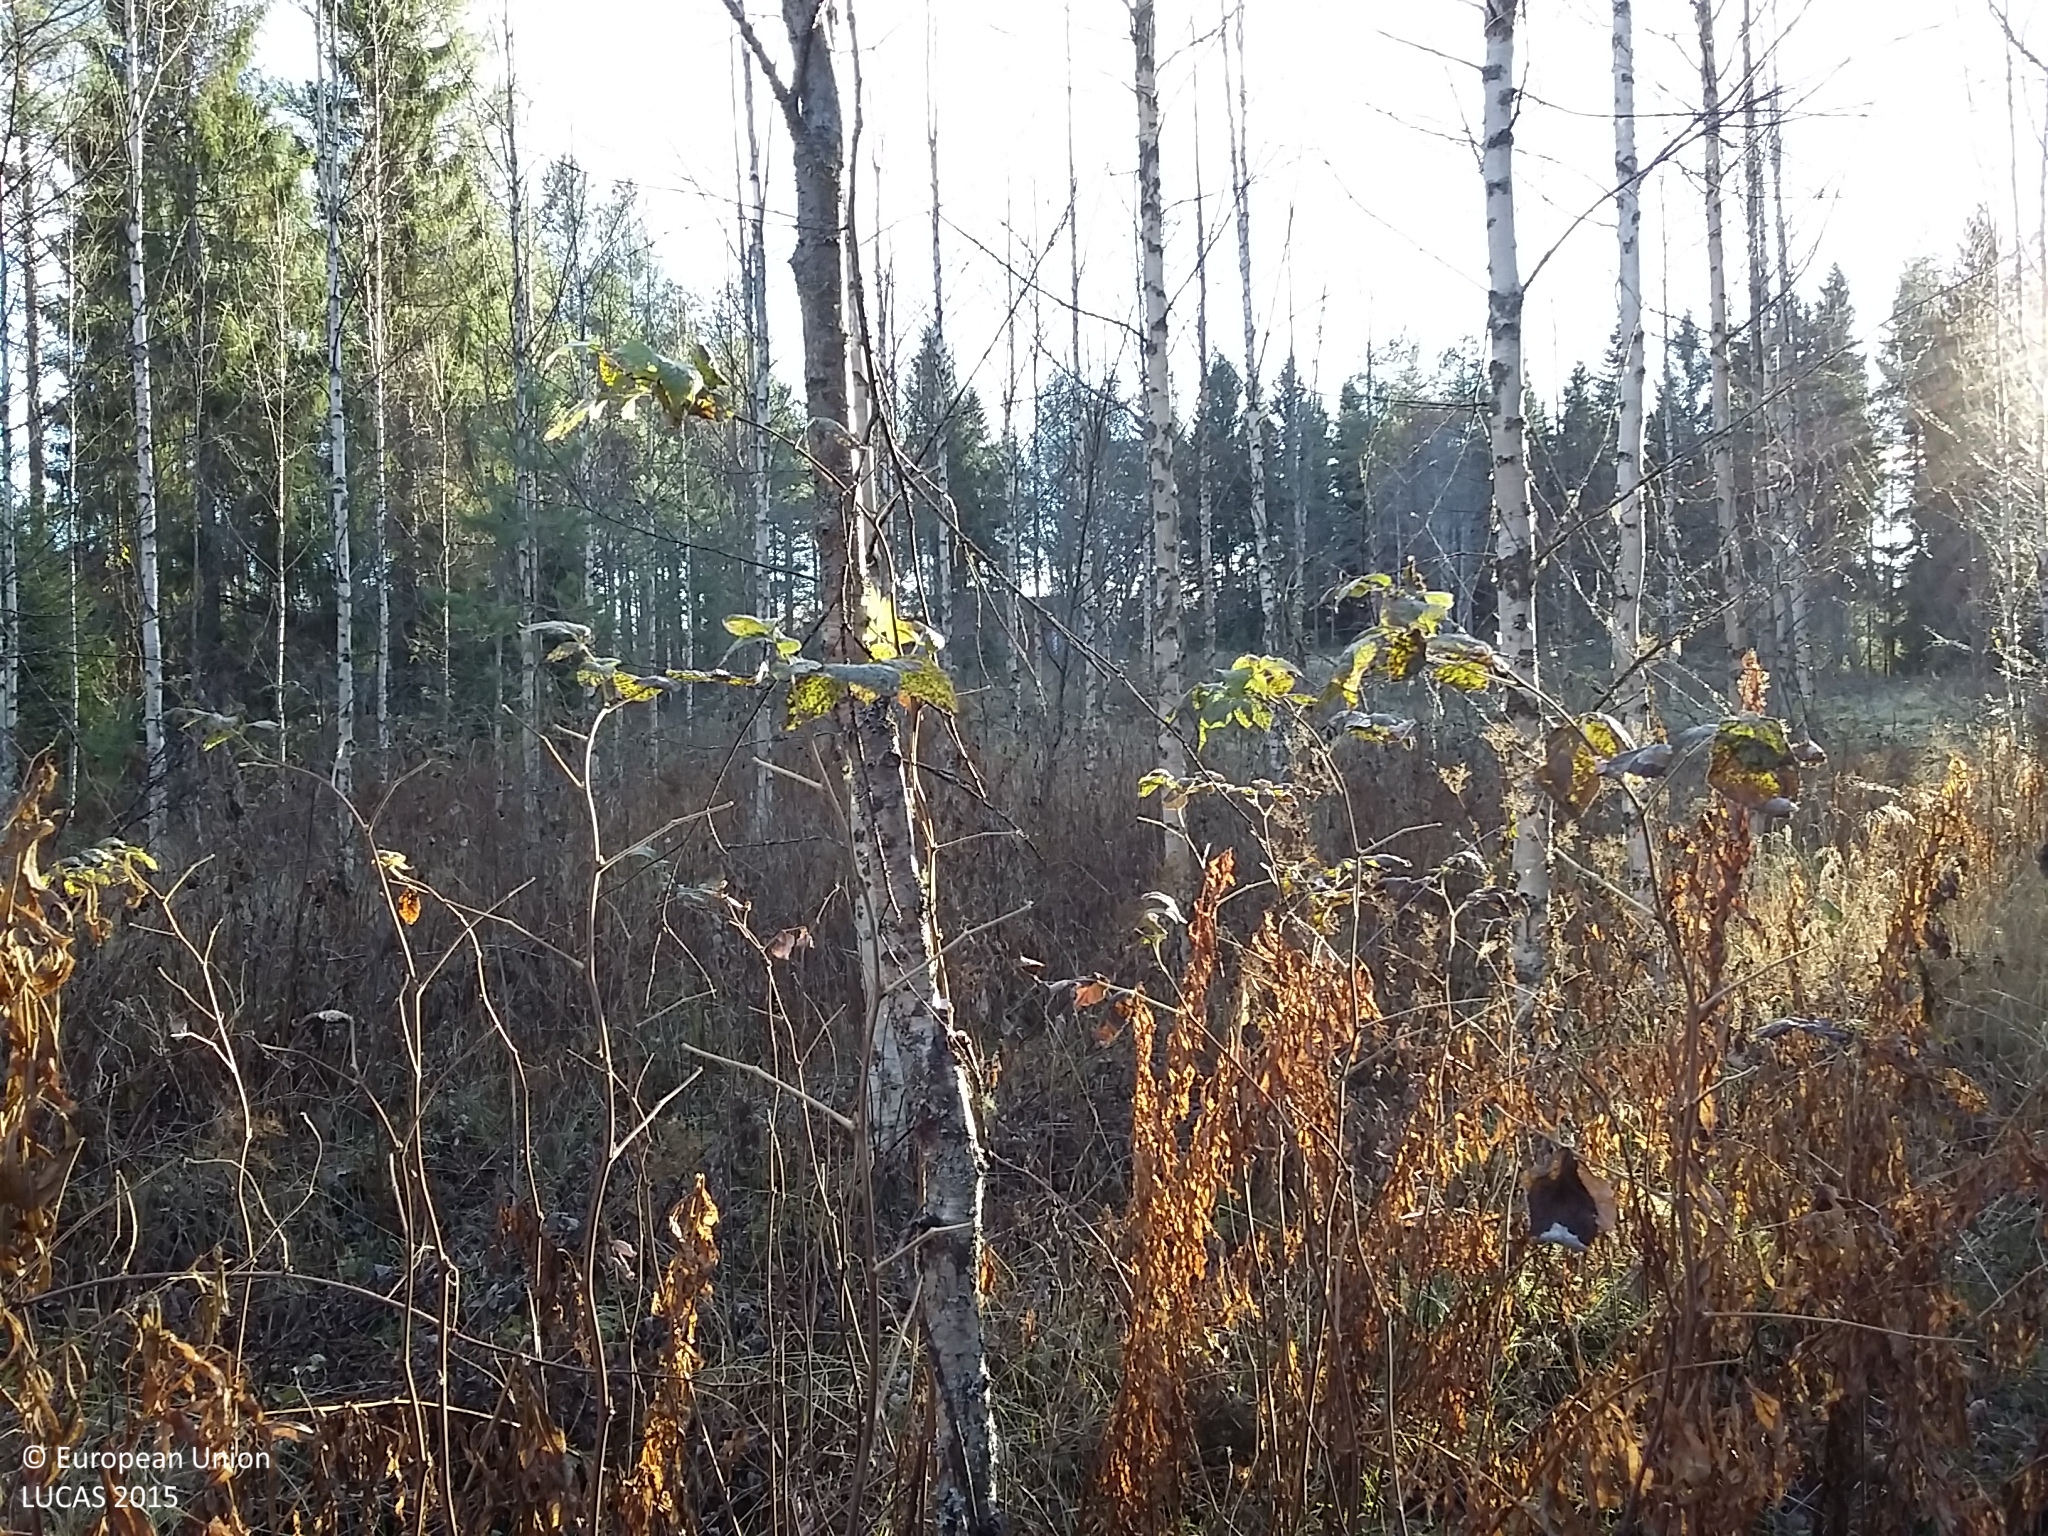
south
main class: Woodland
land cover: Broadleaved woodland
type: non-riverine alder, birch or aspen forest
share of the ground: 50 - 75 %
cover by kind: broadleaved forest trees 70 %, shrubs 15 %, herbaceous plants 15 %
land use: Forestry
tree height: > 5 m
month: October
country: FI
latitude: 64.5498
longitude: 25.5450
